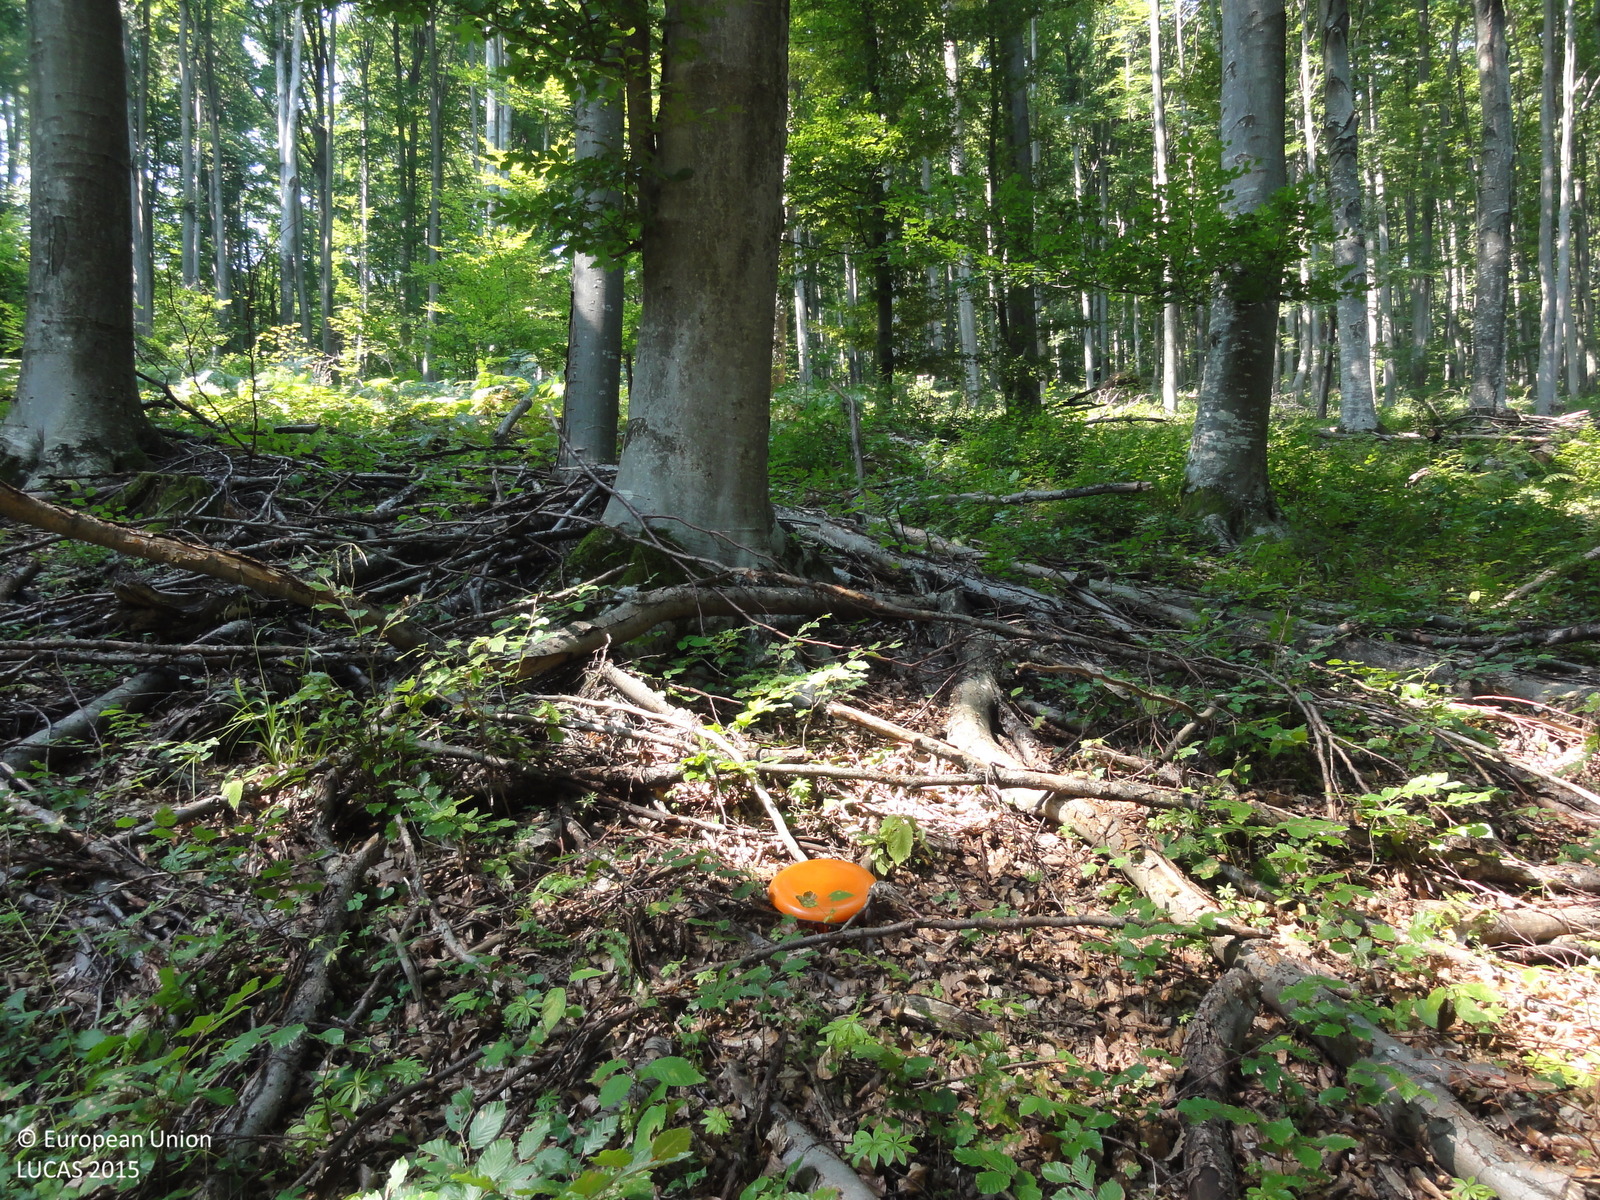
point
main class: Woodland
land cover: Broadleaved woodland
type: beech forest
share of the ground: > 75 %
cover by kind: broadleaved forest trees 90 %, coniferous forest trees 5 %, herbaceous plants 5 %
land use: Forestry
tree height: > 5 m
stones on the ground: < 10 %
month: August
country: SI
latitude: 45.7807
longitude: 15.0510
